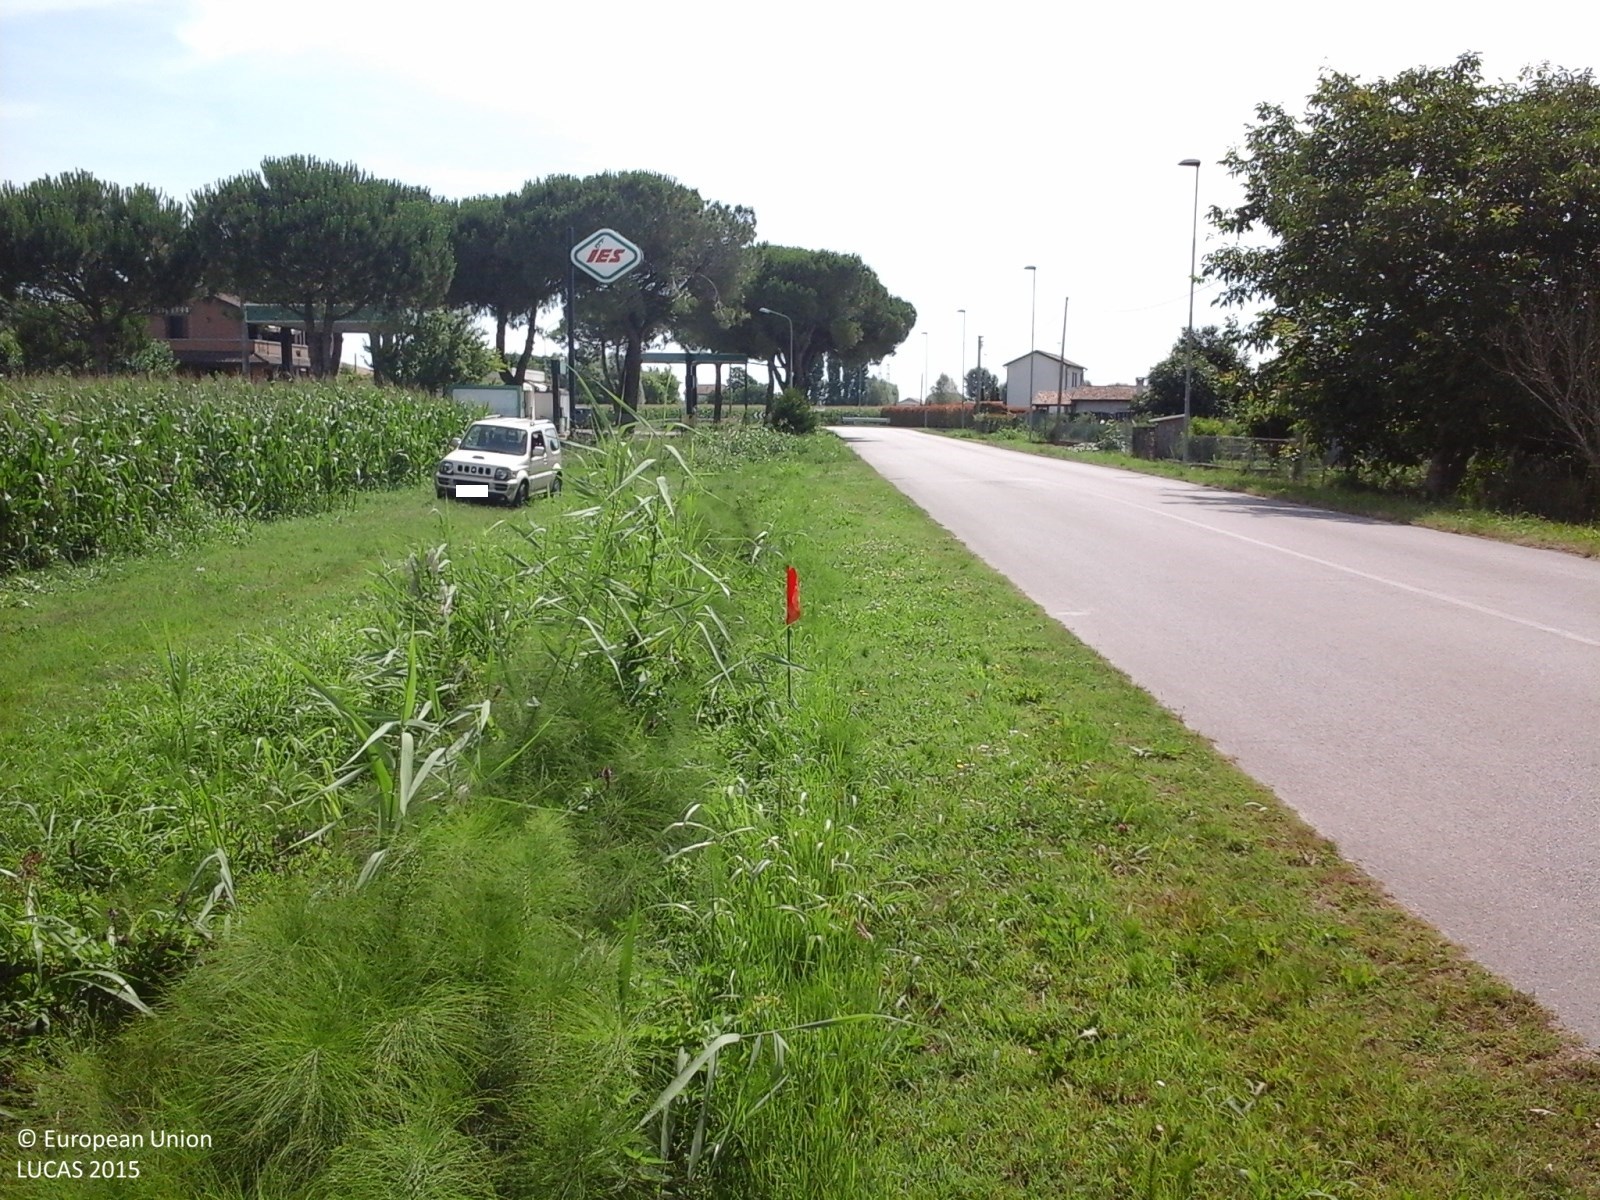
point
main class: Artificial land
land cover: Non built-up linear features
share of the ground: > 75 %
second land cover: Grassland without tree/shrub cover
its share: > 75 %
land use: Road transport
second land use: Agriculture (excluding fallow land and kitchen gardens)
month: June
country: IT
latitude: 44.9352
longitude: 12.4412
